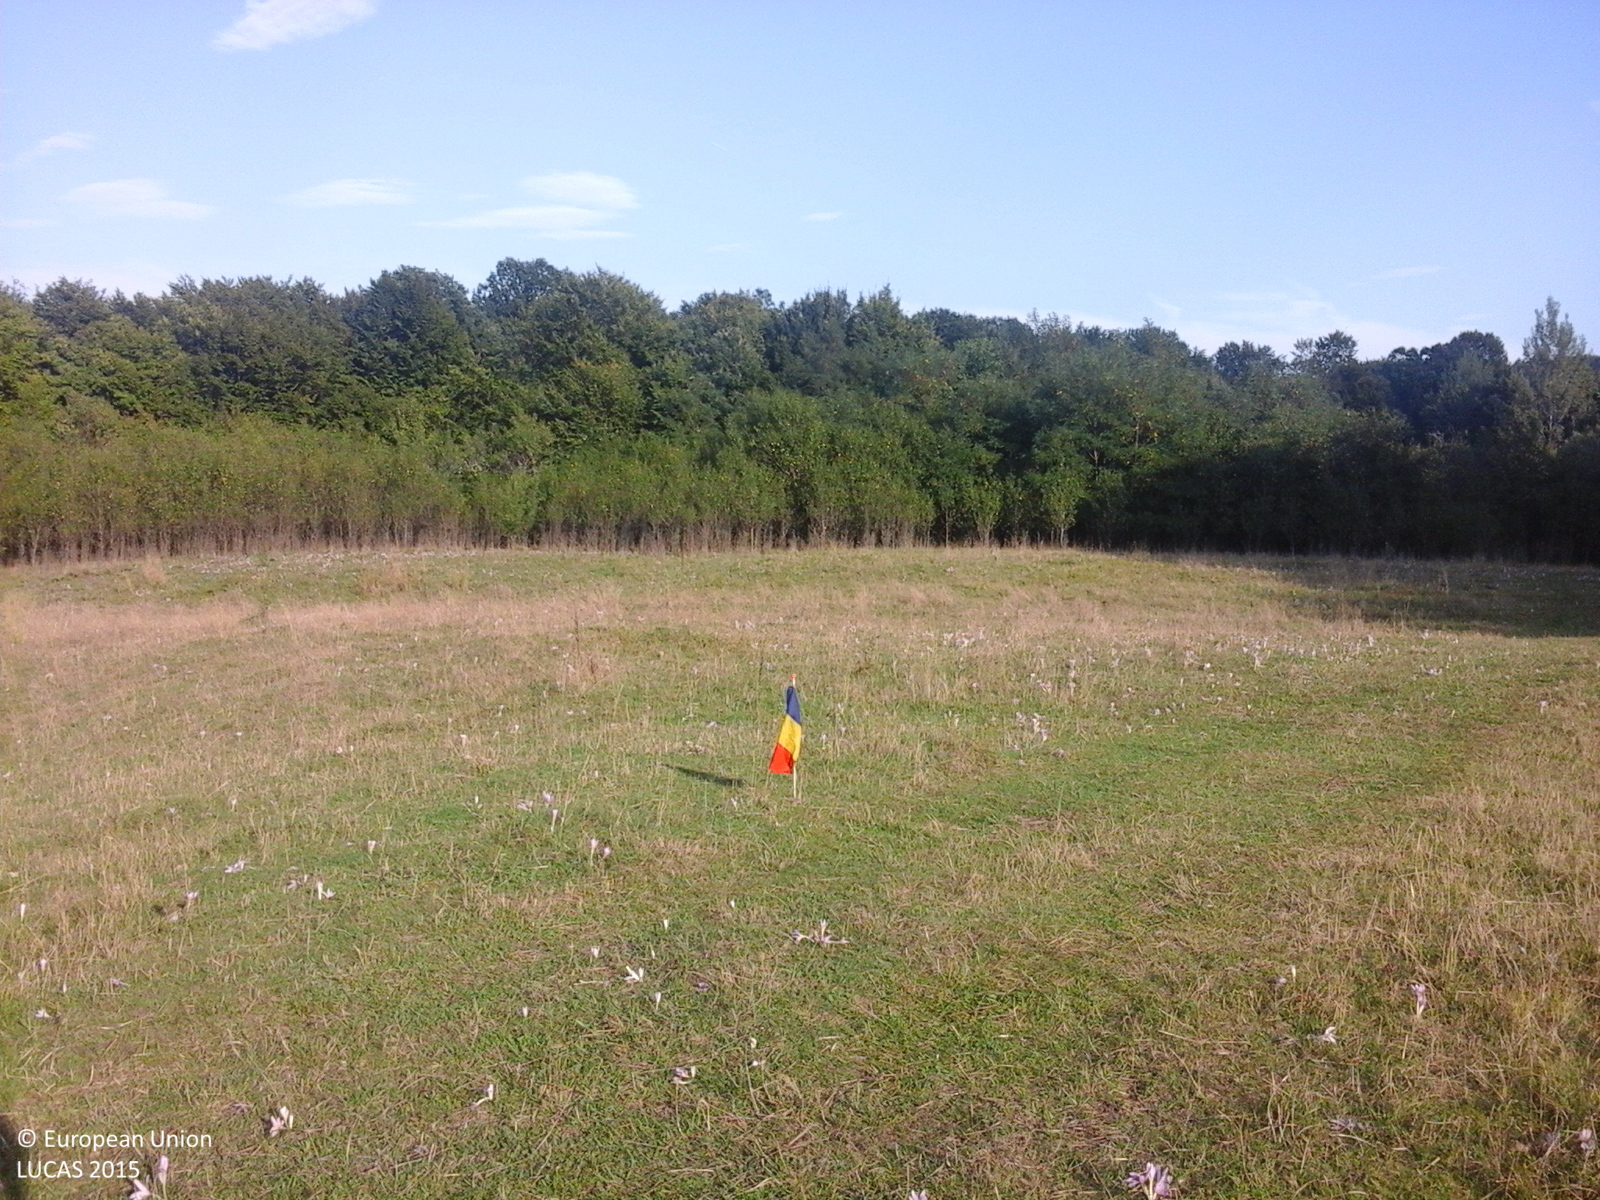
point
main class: Grassland
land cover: Grassland without tree/shrub cover
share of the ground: > 75 %
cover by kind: herbaceous plants 100 %
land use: Agriculture (excluding fallow land and kitchen gardens)
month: September
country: RO
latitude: 45.7732
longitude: 22.8480
